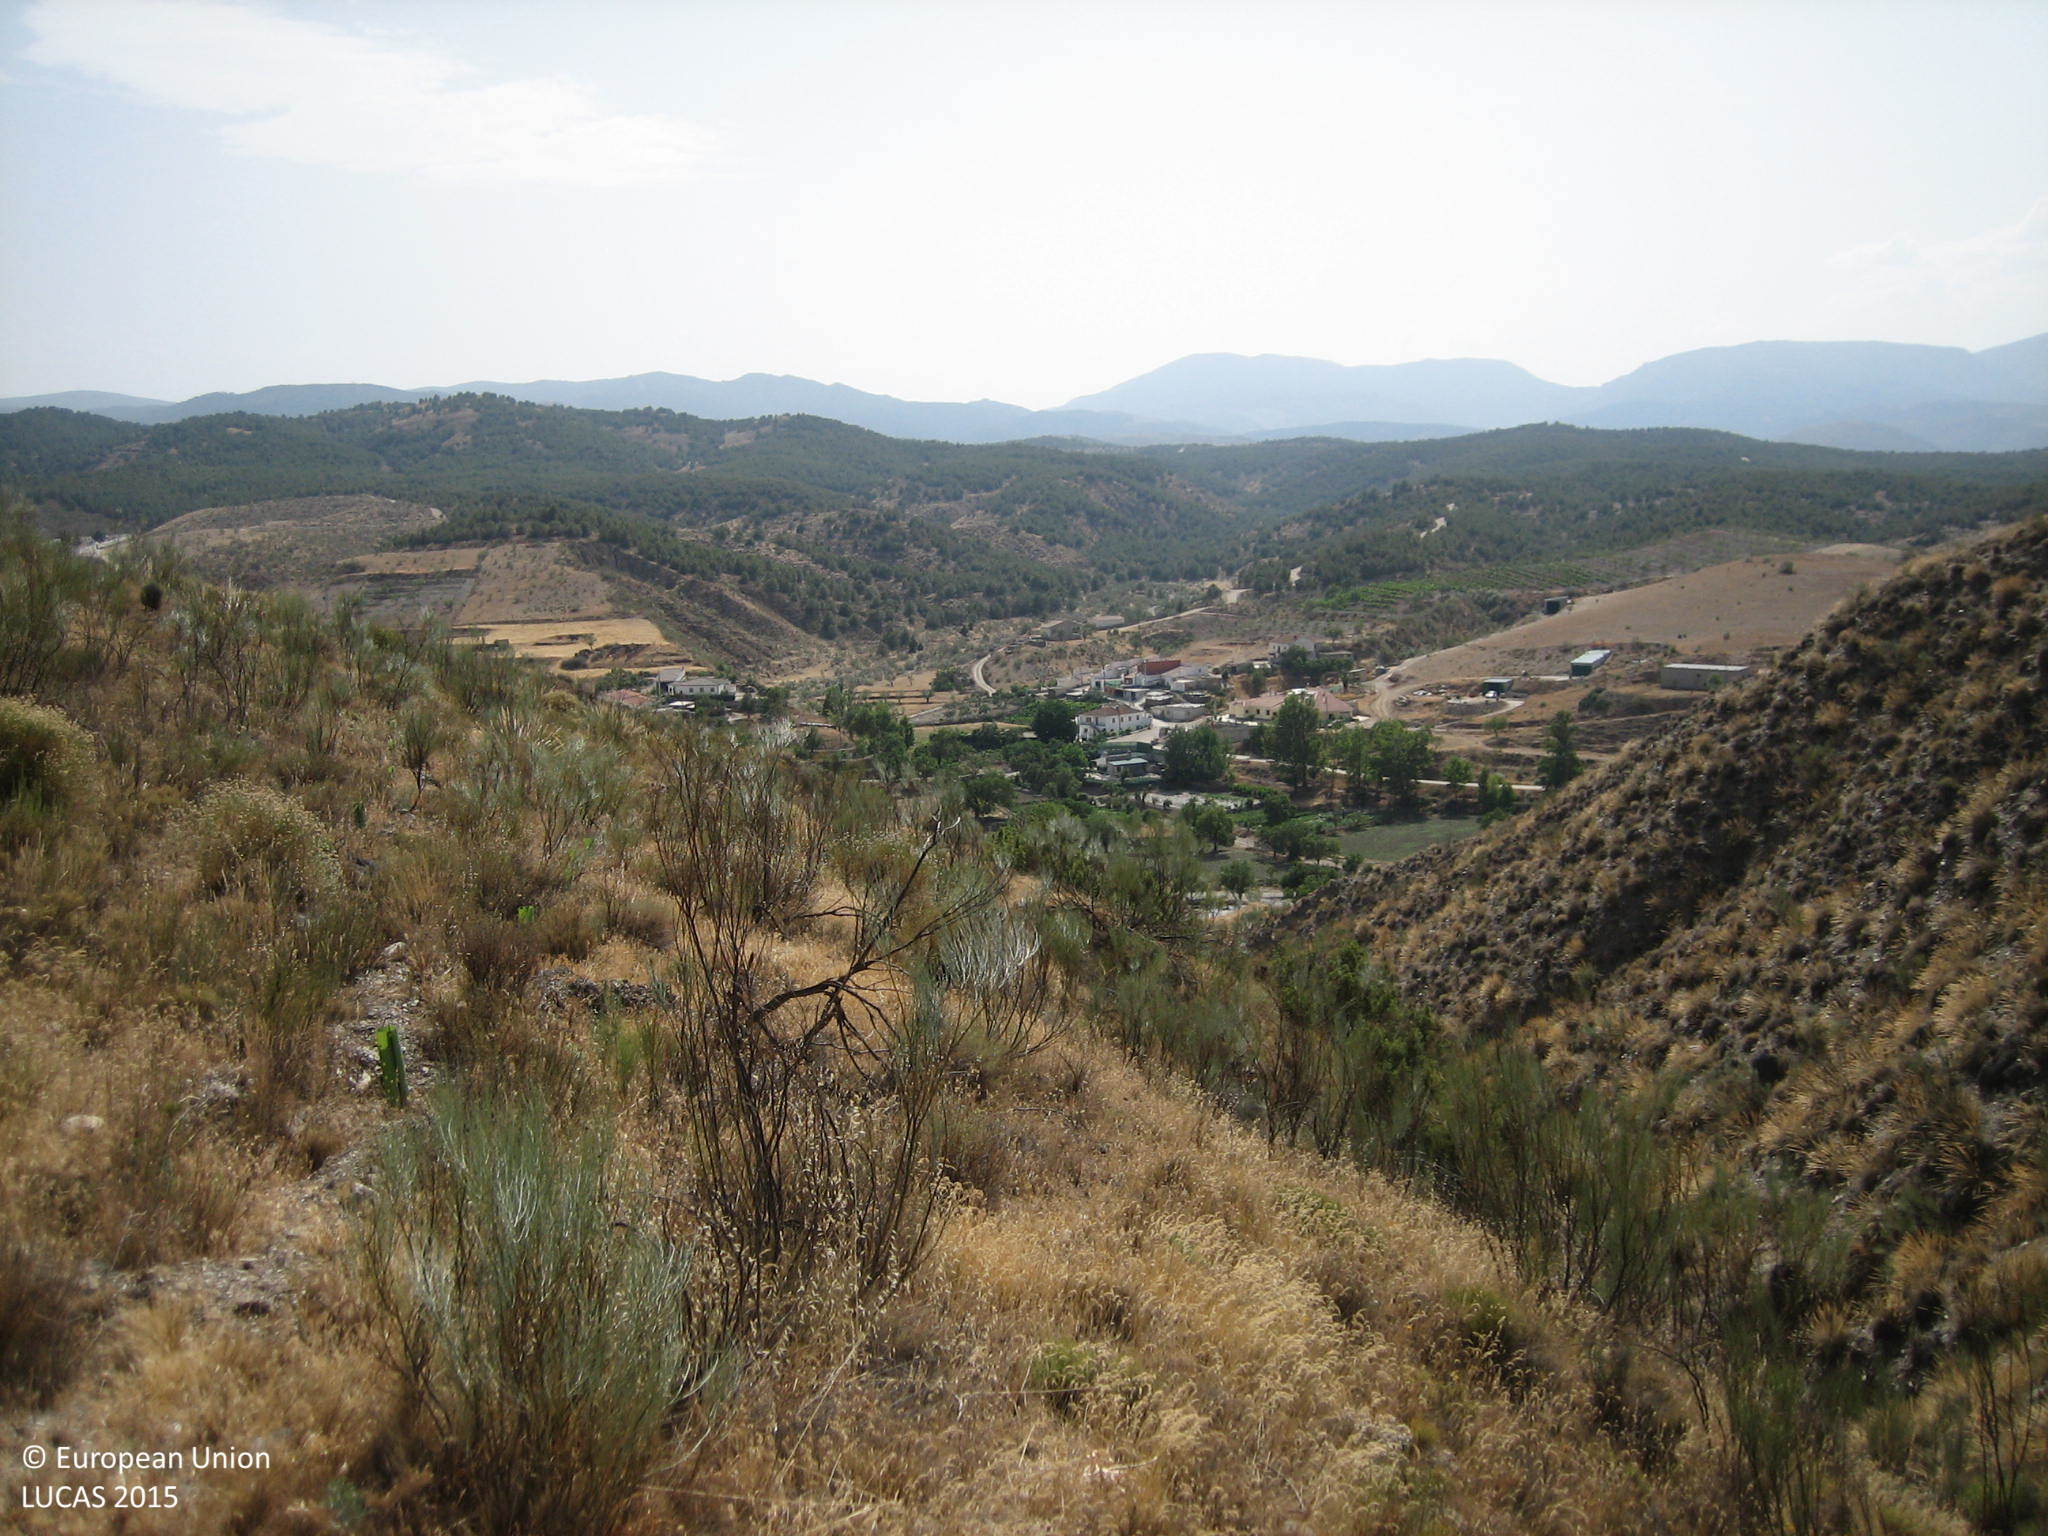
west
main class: Shrubland
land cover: Shrubland without tree cover
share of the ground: 25 - 50 %
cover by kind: herbaceous plants 60 %, shrubs 40 %
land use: Forestry
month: July
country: ES
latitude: 37.3557
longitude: -2.6627
